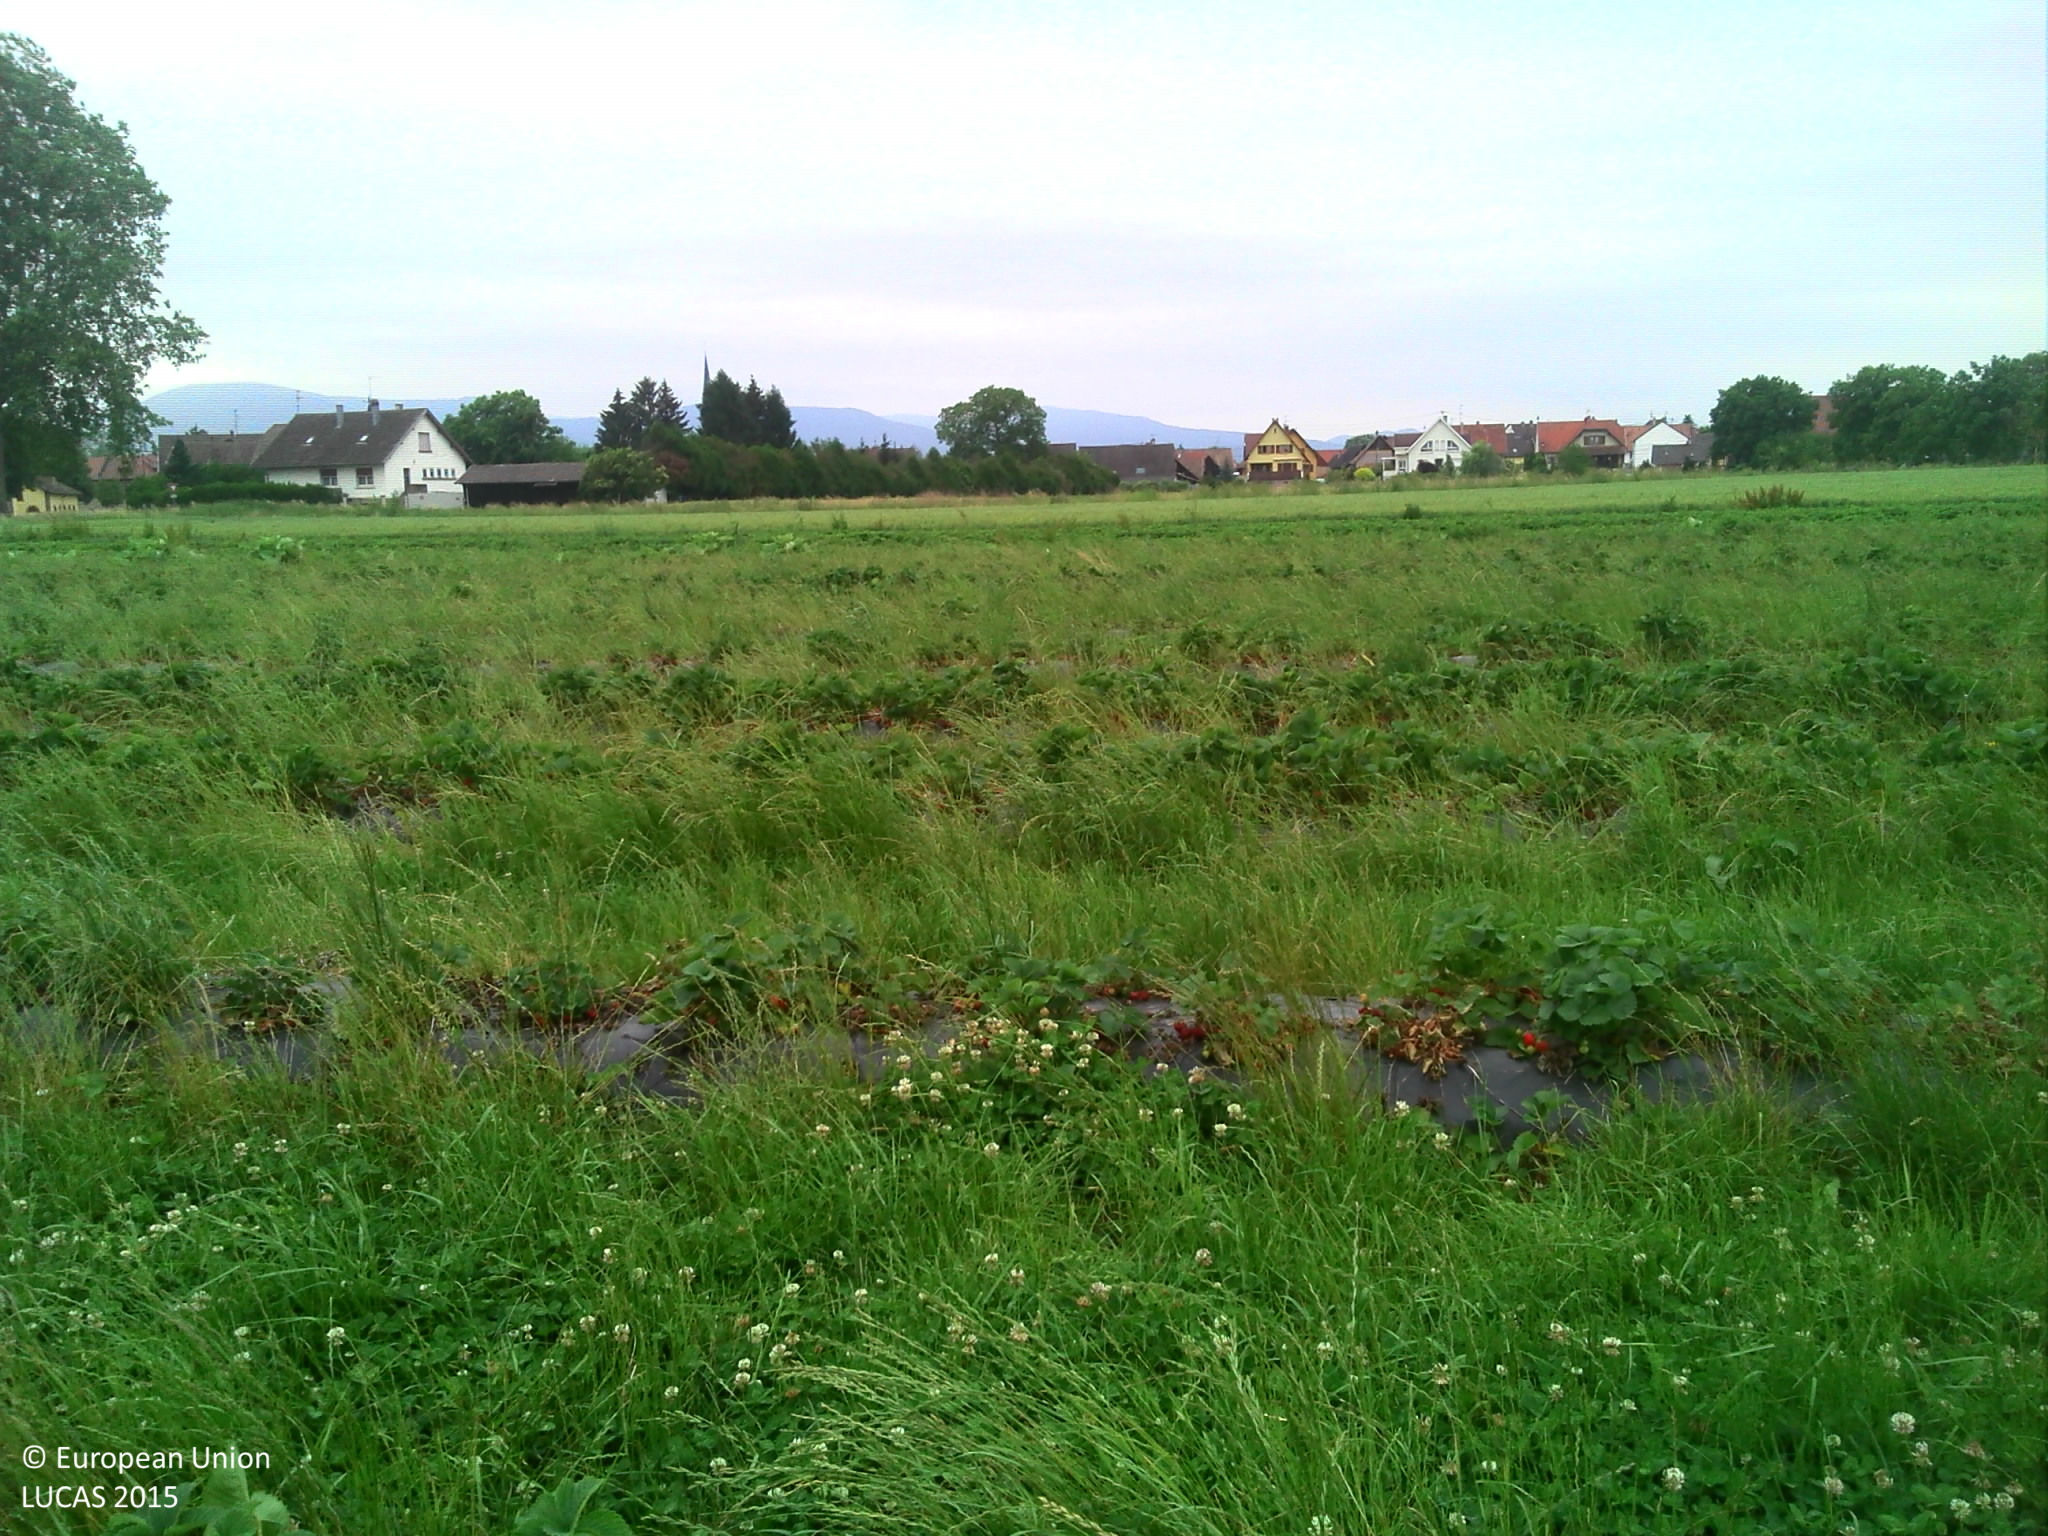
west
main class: Cropland
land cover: Strawberries
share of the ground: 50 - 75 %
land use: Agriculture (excluding fallow land and kitchen gardens)
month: June
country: FR
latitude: 48.4485
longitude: 7.5538
